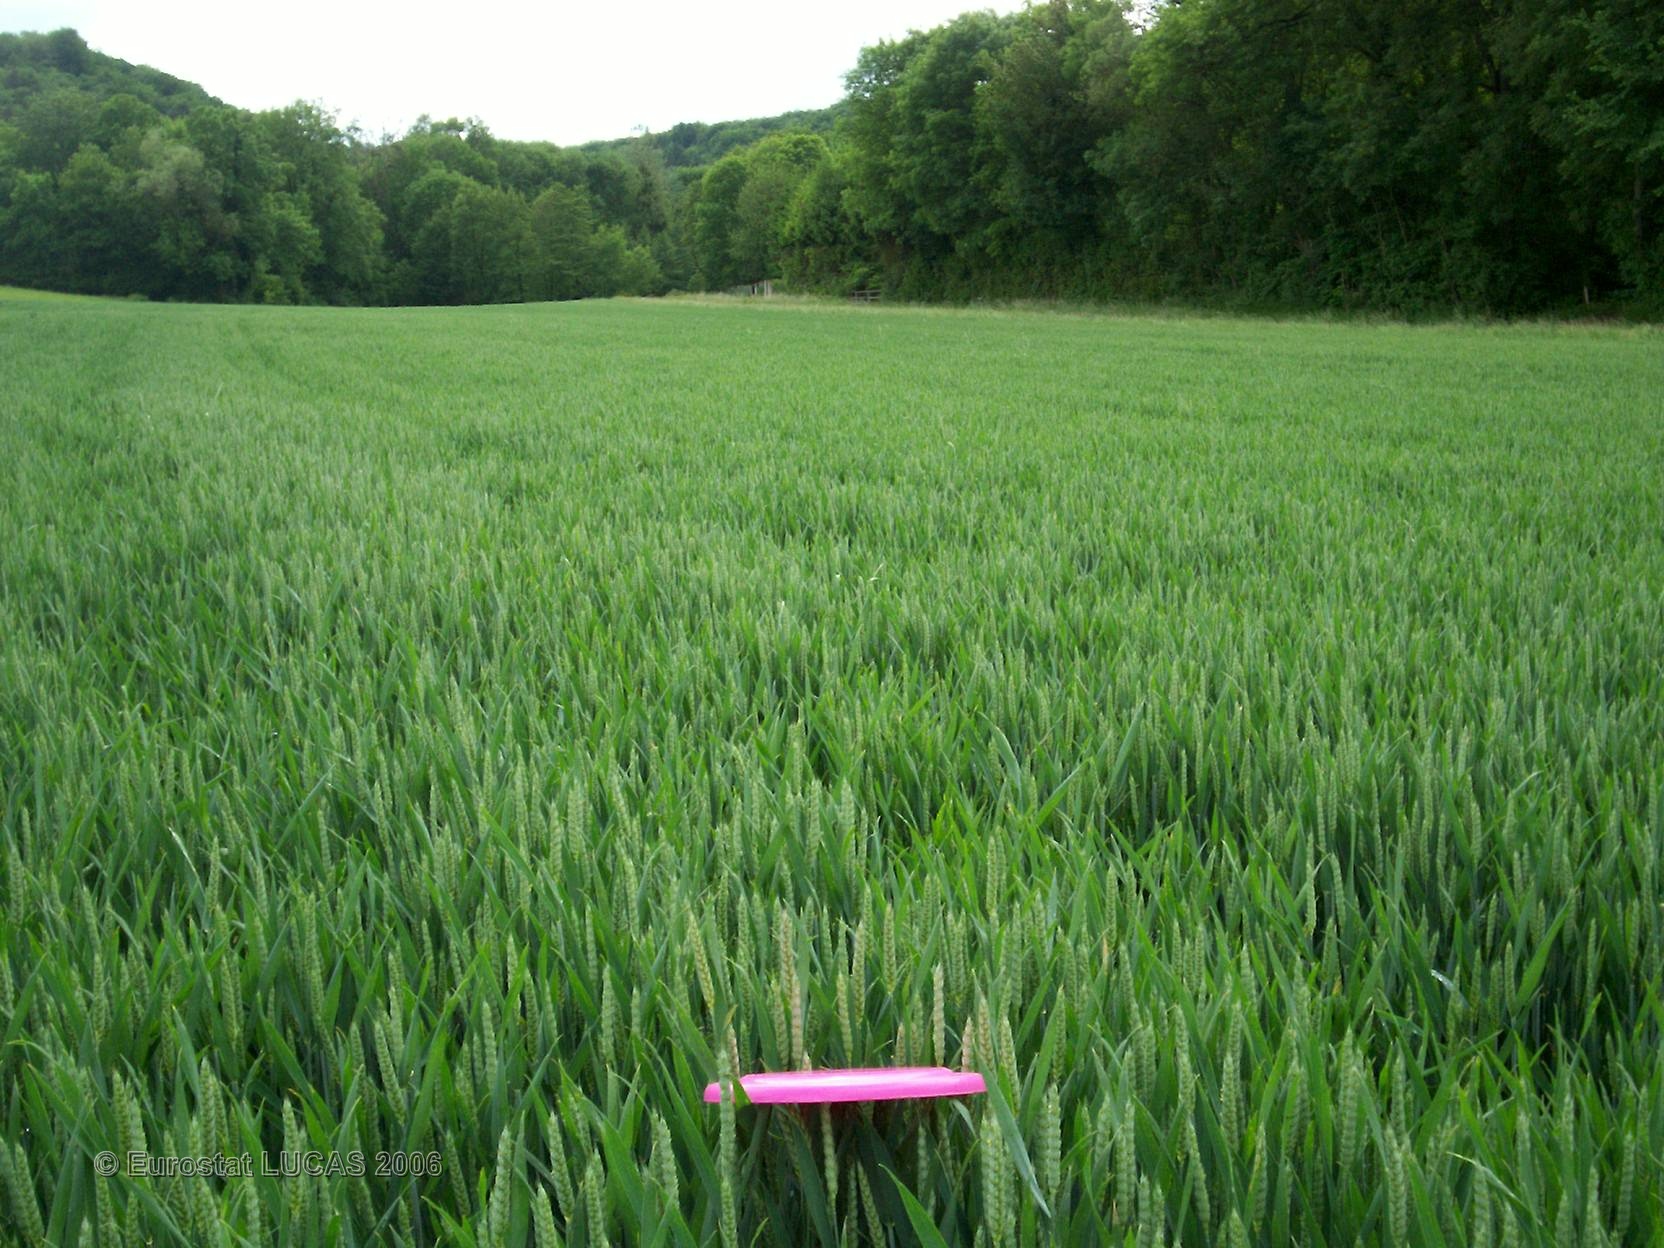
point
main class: Cropland
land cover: Common wheat
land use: Agriculture (excluding fallow land and kitchen gardens)
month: May
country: FR
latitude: 48.2394
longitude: 4.6795
